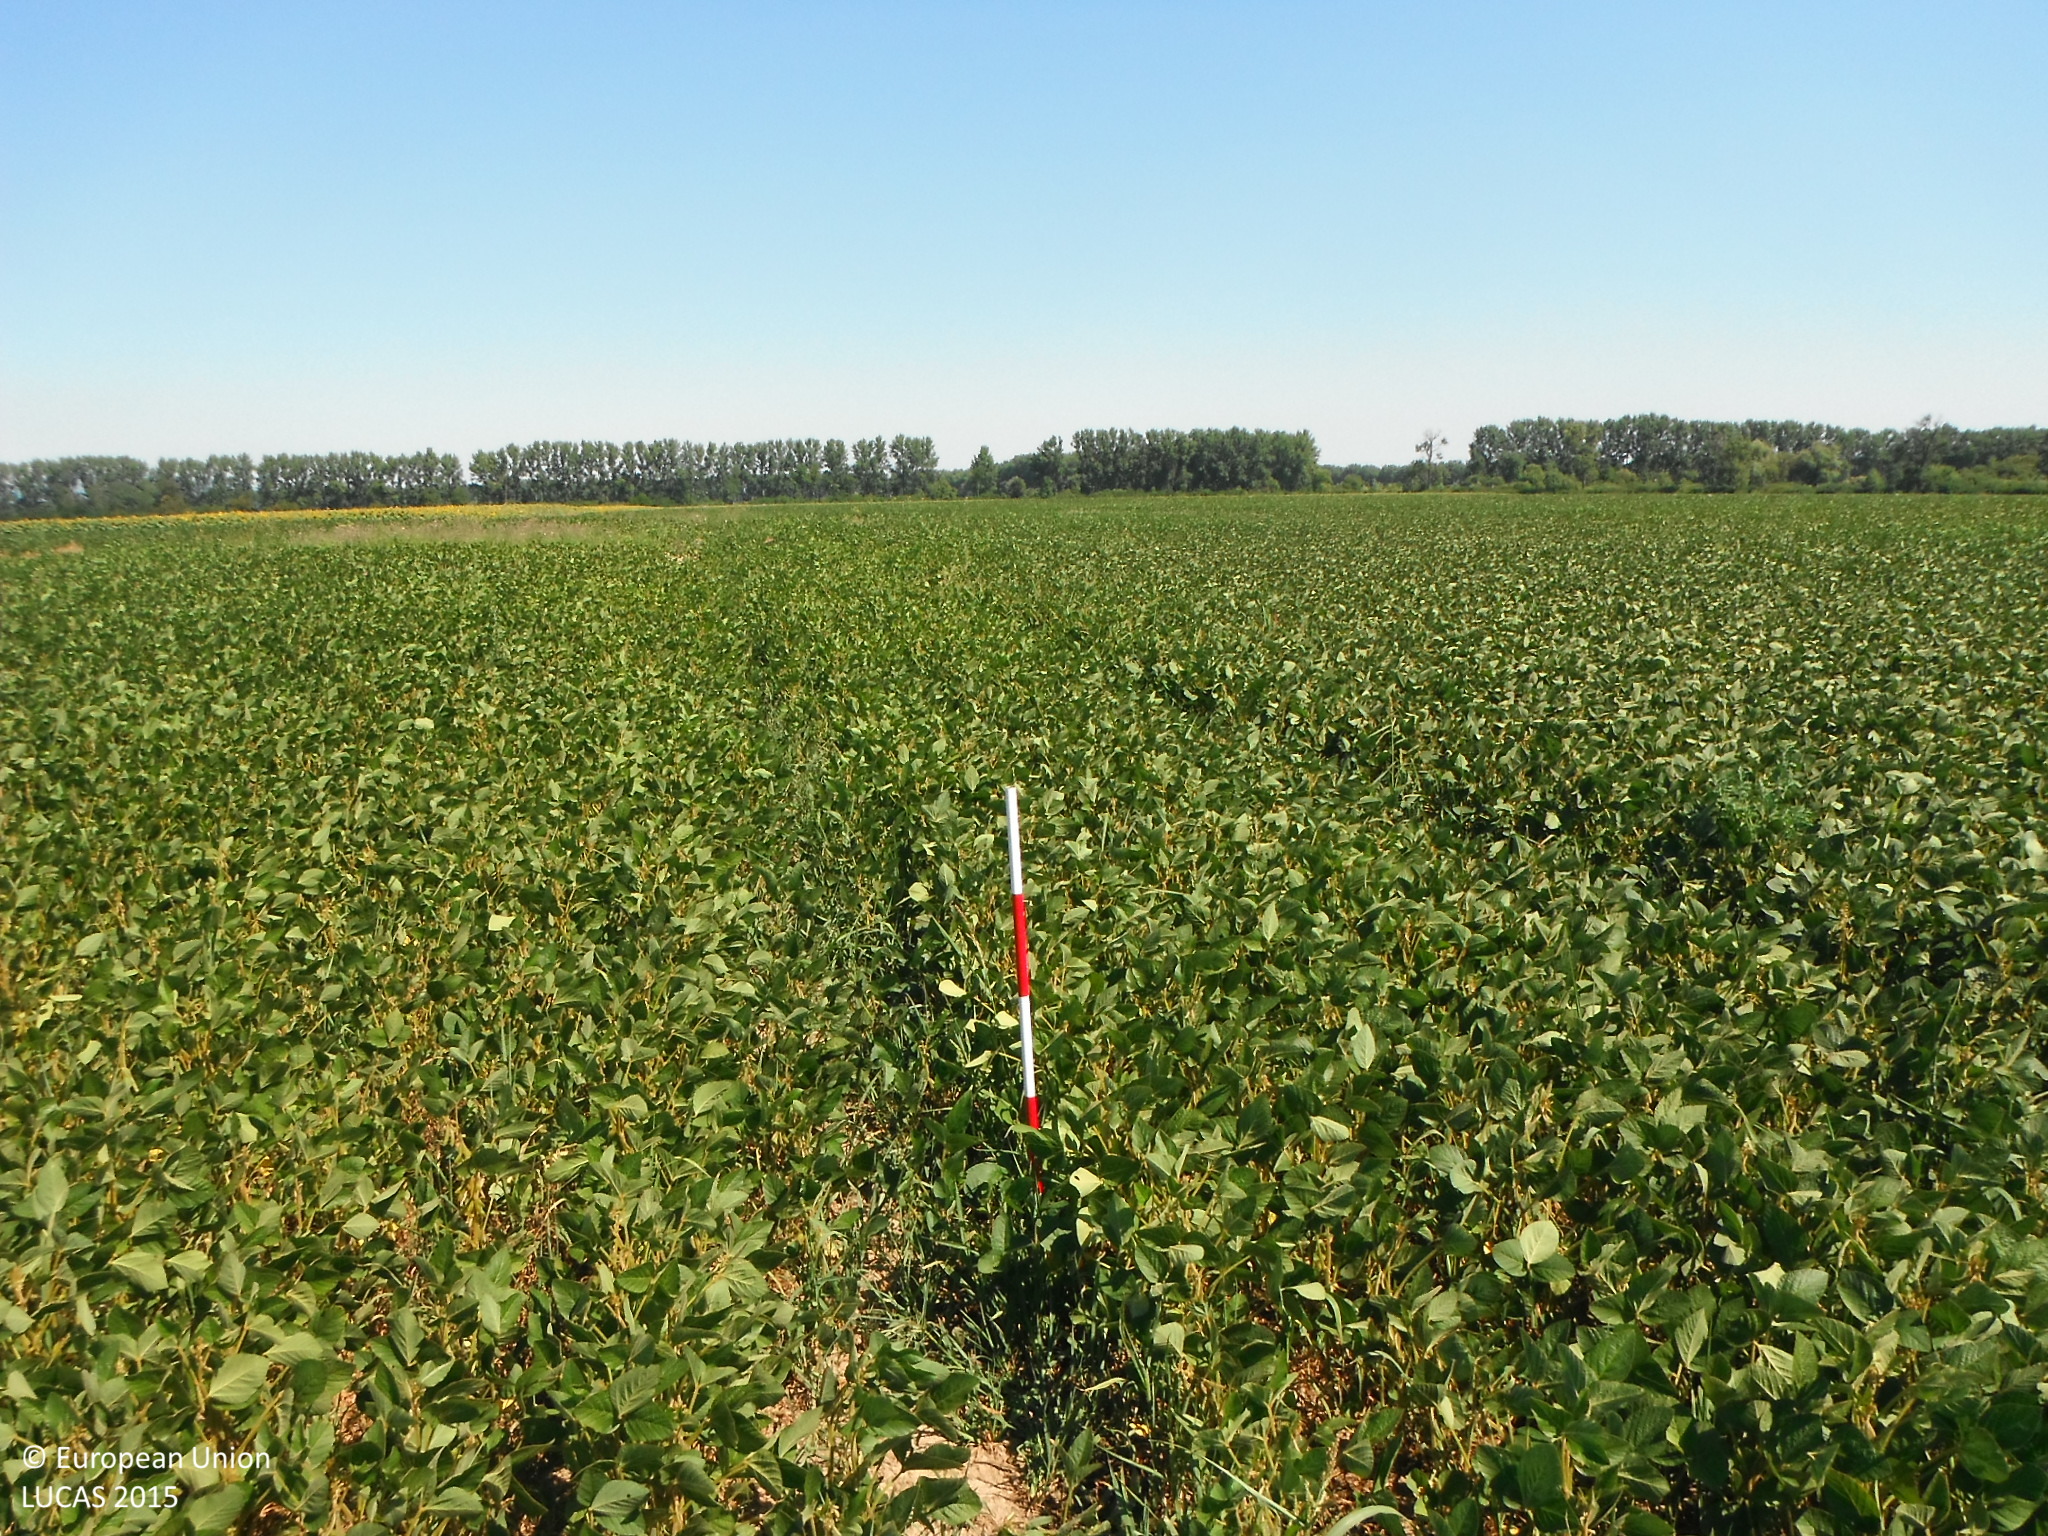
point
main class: Cropland
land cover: Soya
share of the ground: > 75 %
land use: Agriculture (excluding fallow land and kitchen gardens)
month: July
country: SK
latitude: 48.6102
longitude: 21.7559
